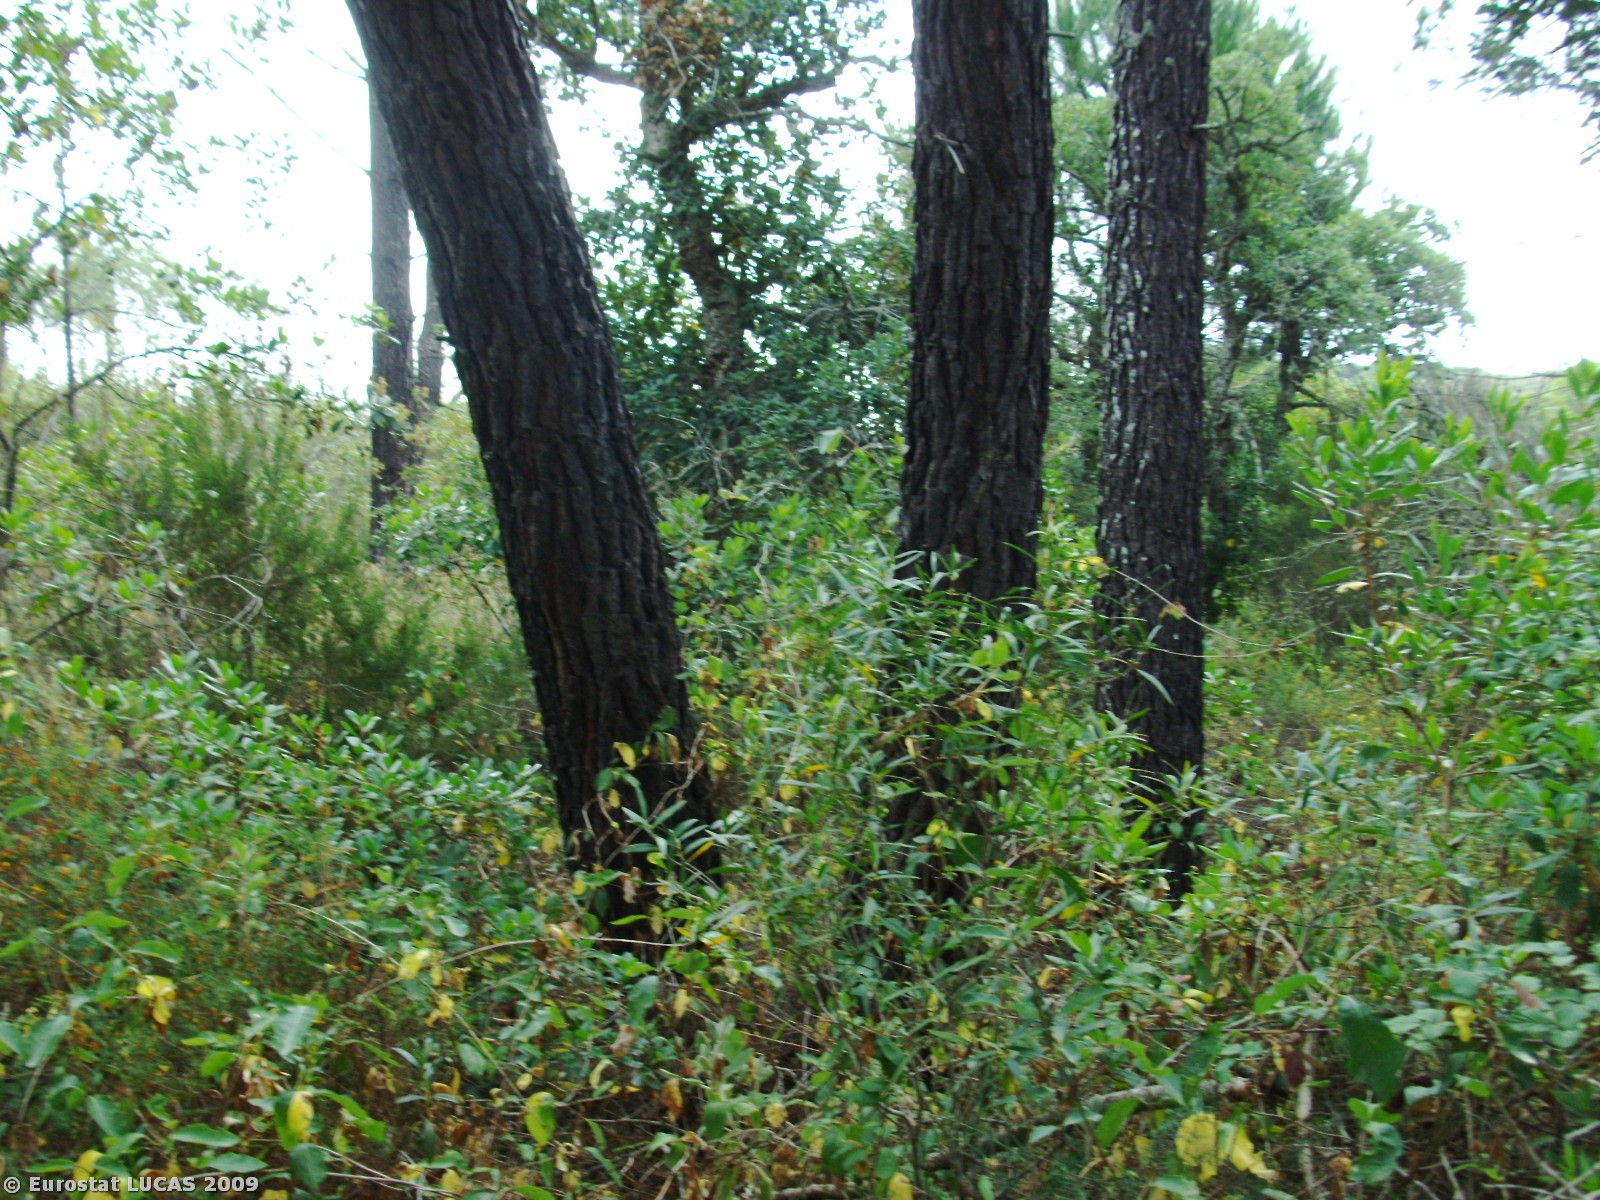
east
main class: Woodland
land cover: Coniferous woodland
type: coniferous forest of the mediterranean region
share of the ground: 25 - 50 %
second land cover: Shrubland with sparse tree cover
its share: 50 - 75 %
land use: Forestry
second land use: Nature reserves
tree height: > 5 m
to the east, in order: Coniferous woodland; Shrubland with sparse tree cover; Rivers and streams; Coniferous woodland; Shrubland with sparse tree cover; Spontaneously vegetated surfaces; Tracks; Shrubland with sparse tree cover; Rivers and streams; Shrubland with sparse tree cover
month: June
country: PT
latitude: 37.1214
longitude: -8.8628
